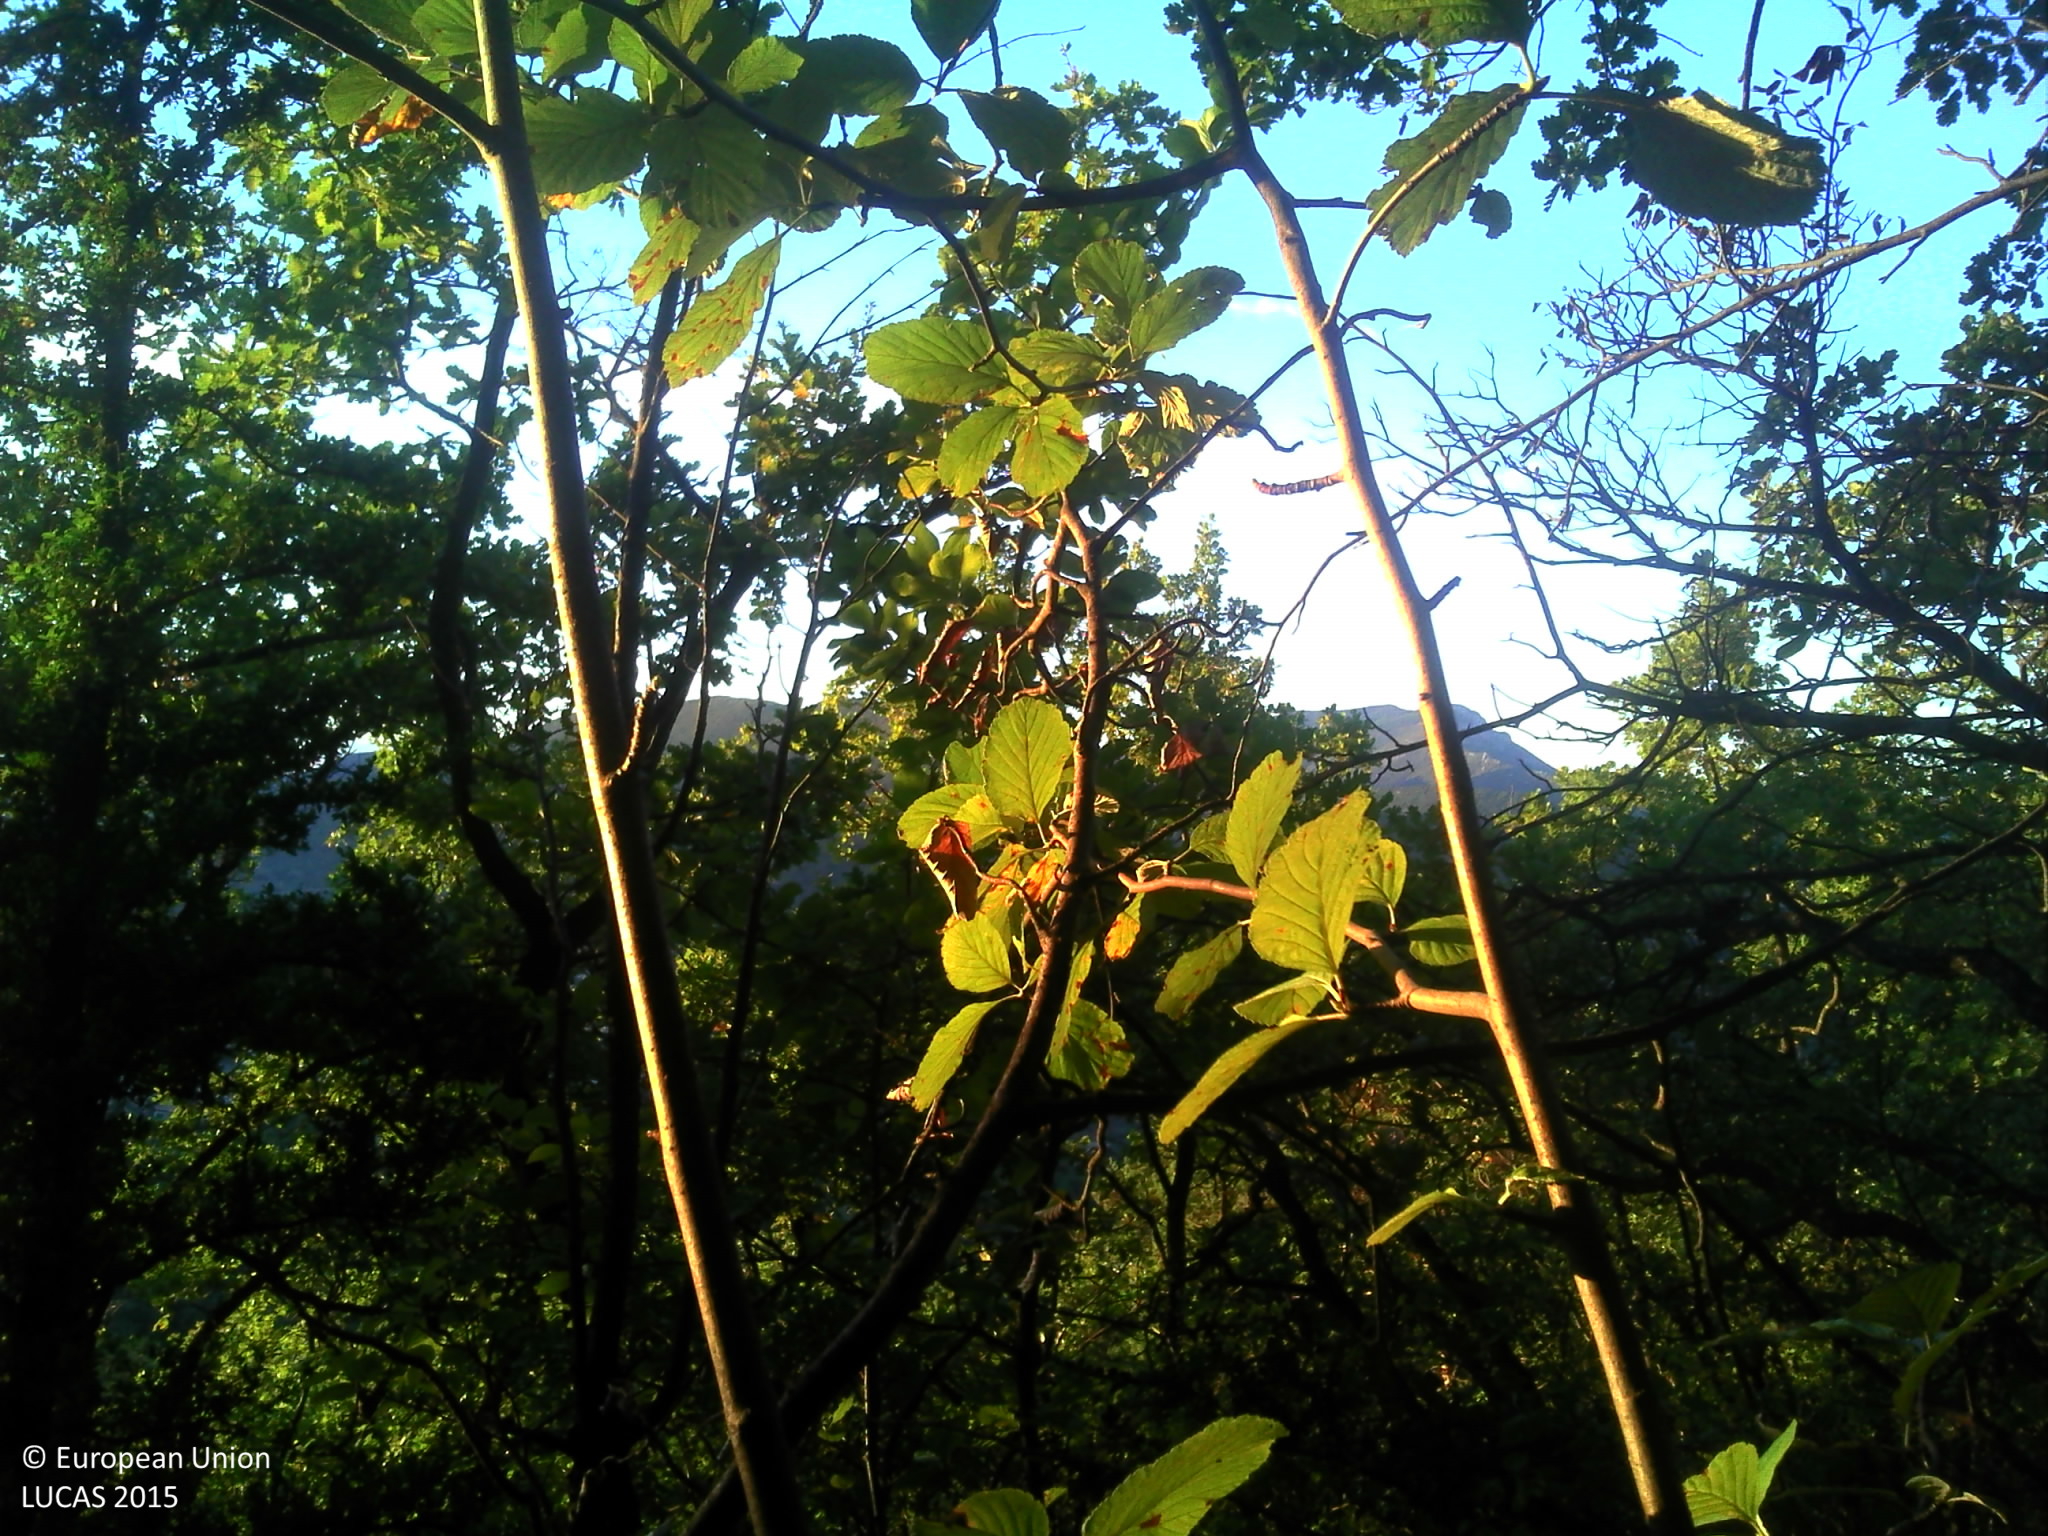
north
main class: Woodland
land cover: Broadleaved woodland
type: mesophytic deciduous forest
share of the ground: > 75 %
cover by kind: broadleaved forest trees 85 %, coniferous forest trees 5 %, shrubs 5 %, lichens and mosses 5 %
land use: Semi-natural and natural areas not in use
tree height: > 5 m
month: September
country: FR
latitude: 44.3457
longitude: 5.1529
